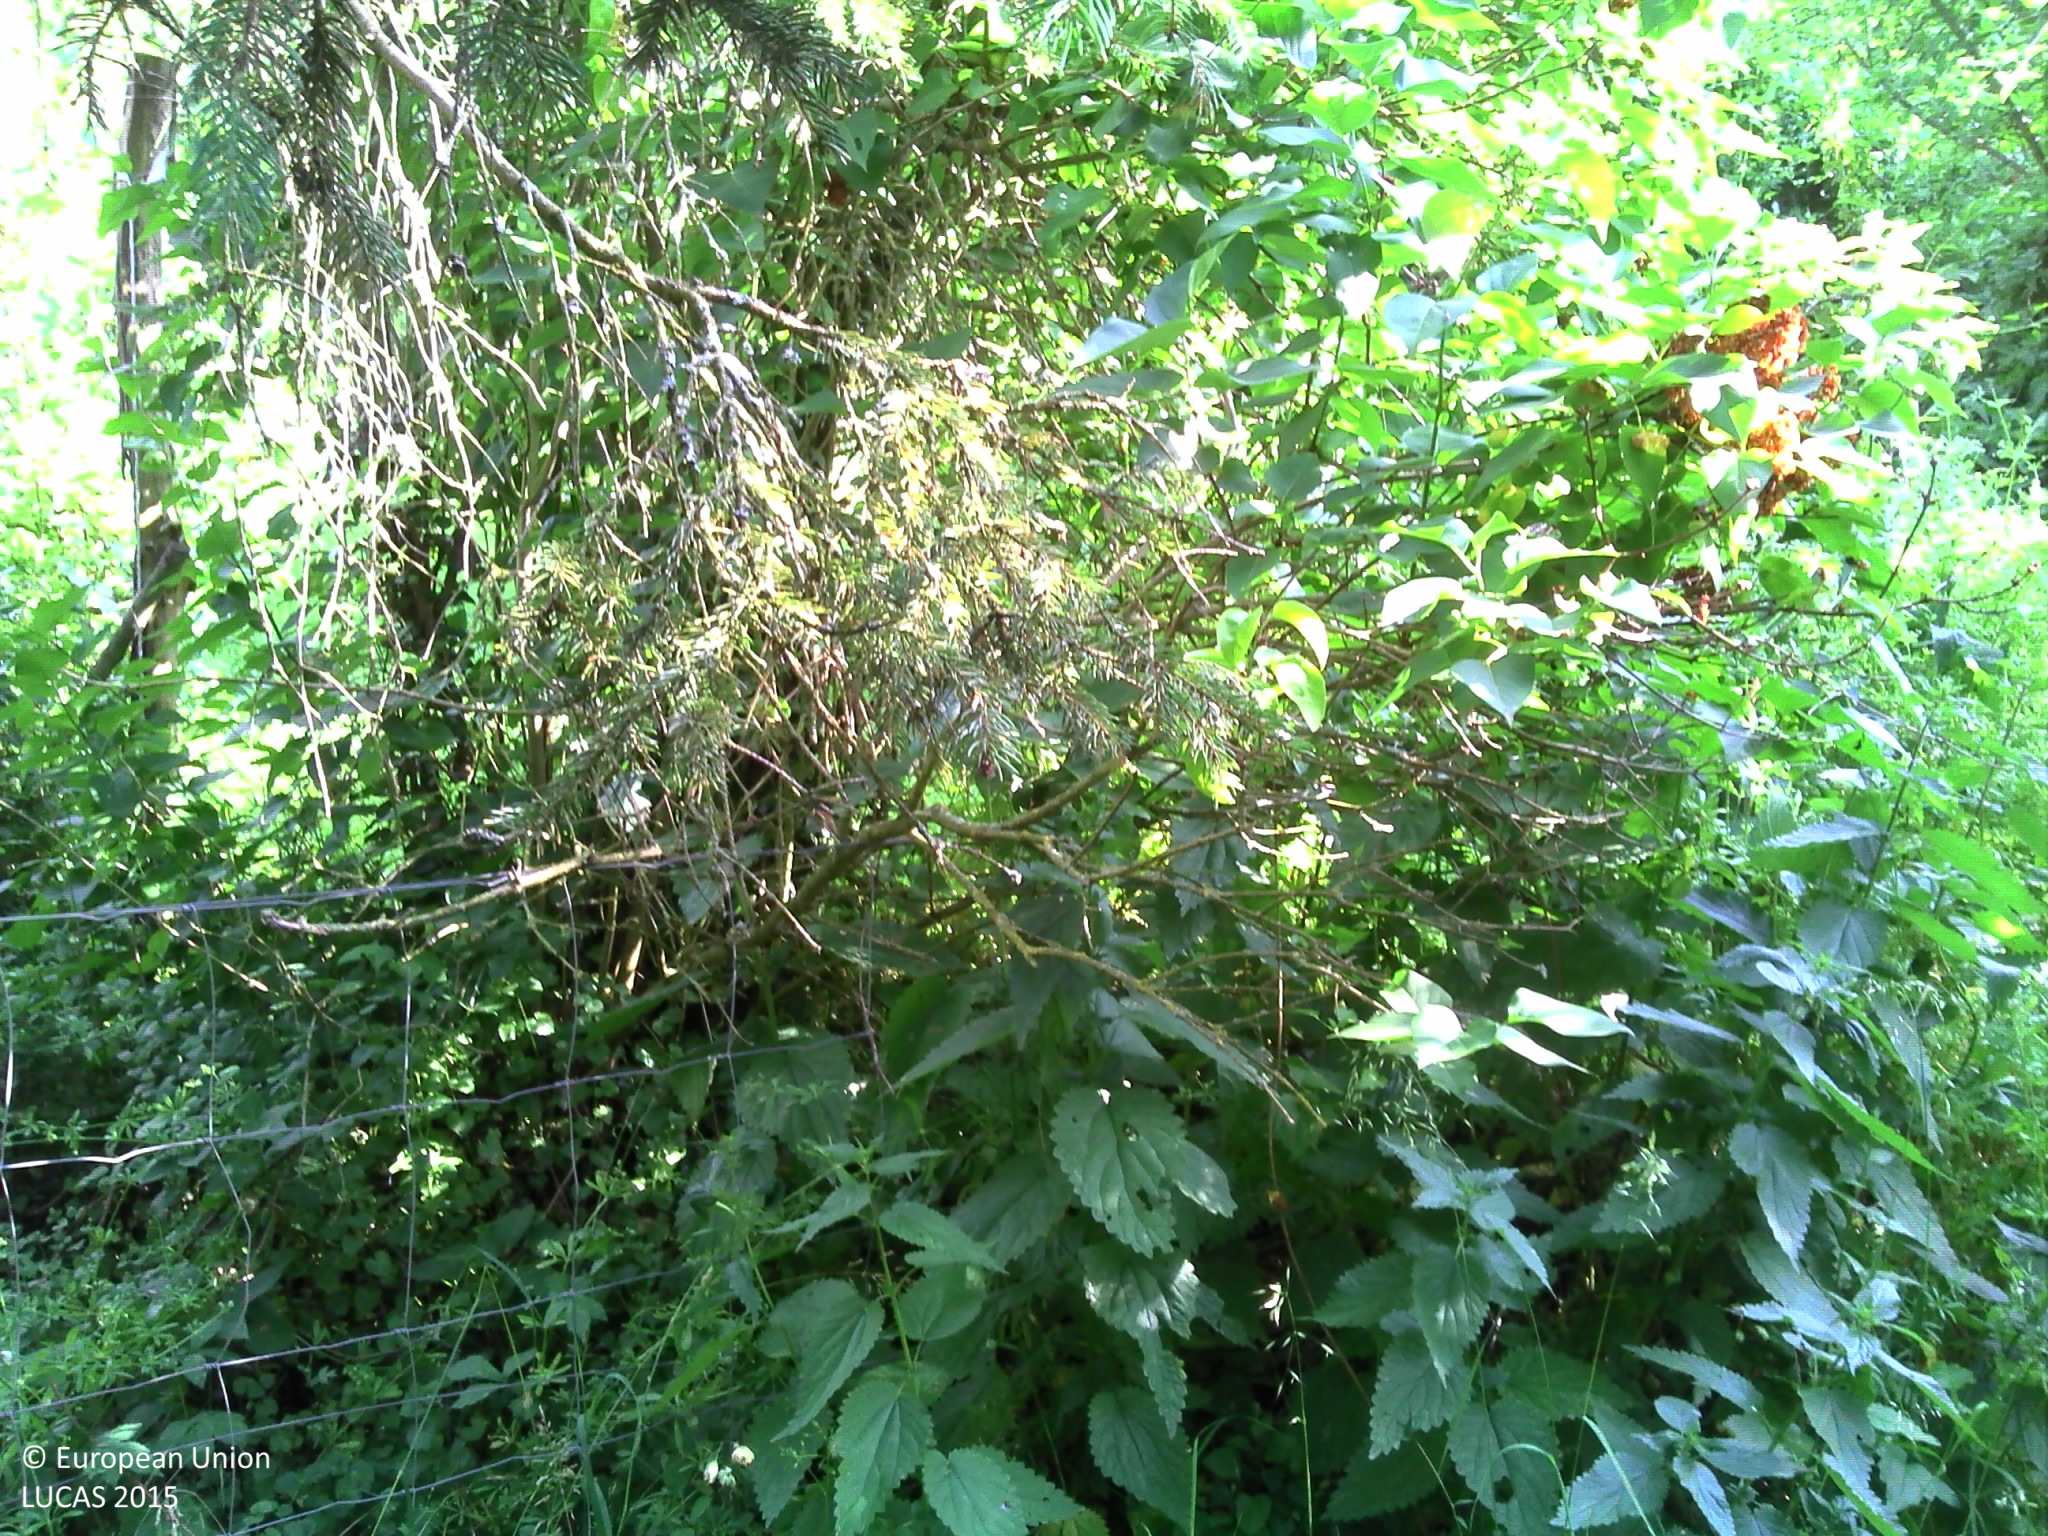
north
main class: Grassland
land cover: Grassland with sparse tree/shrub cover
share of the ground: > 75 %
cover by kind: herbaceous plants 95 %, broadleaved forest trees 5 %
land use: Residential
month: June
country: FR
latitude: 48.7554
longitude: 6.2867
